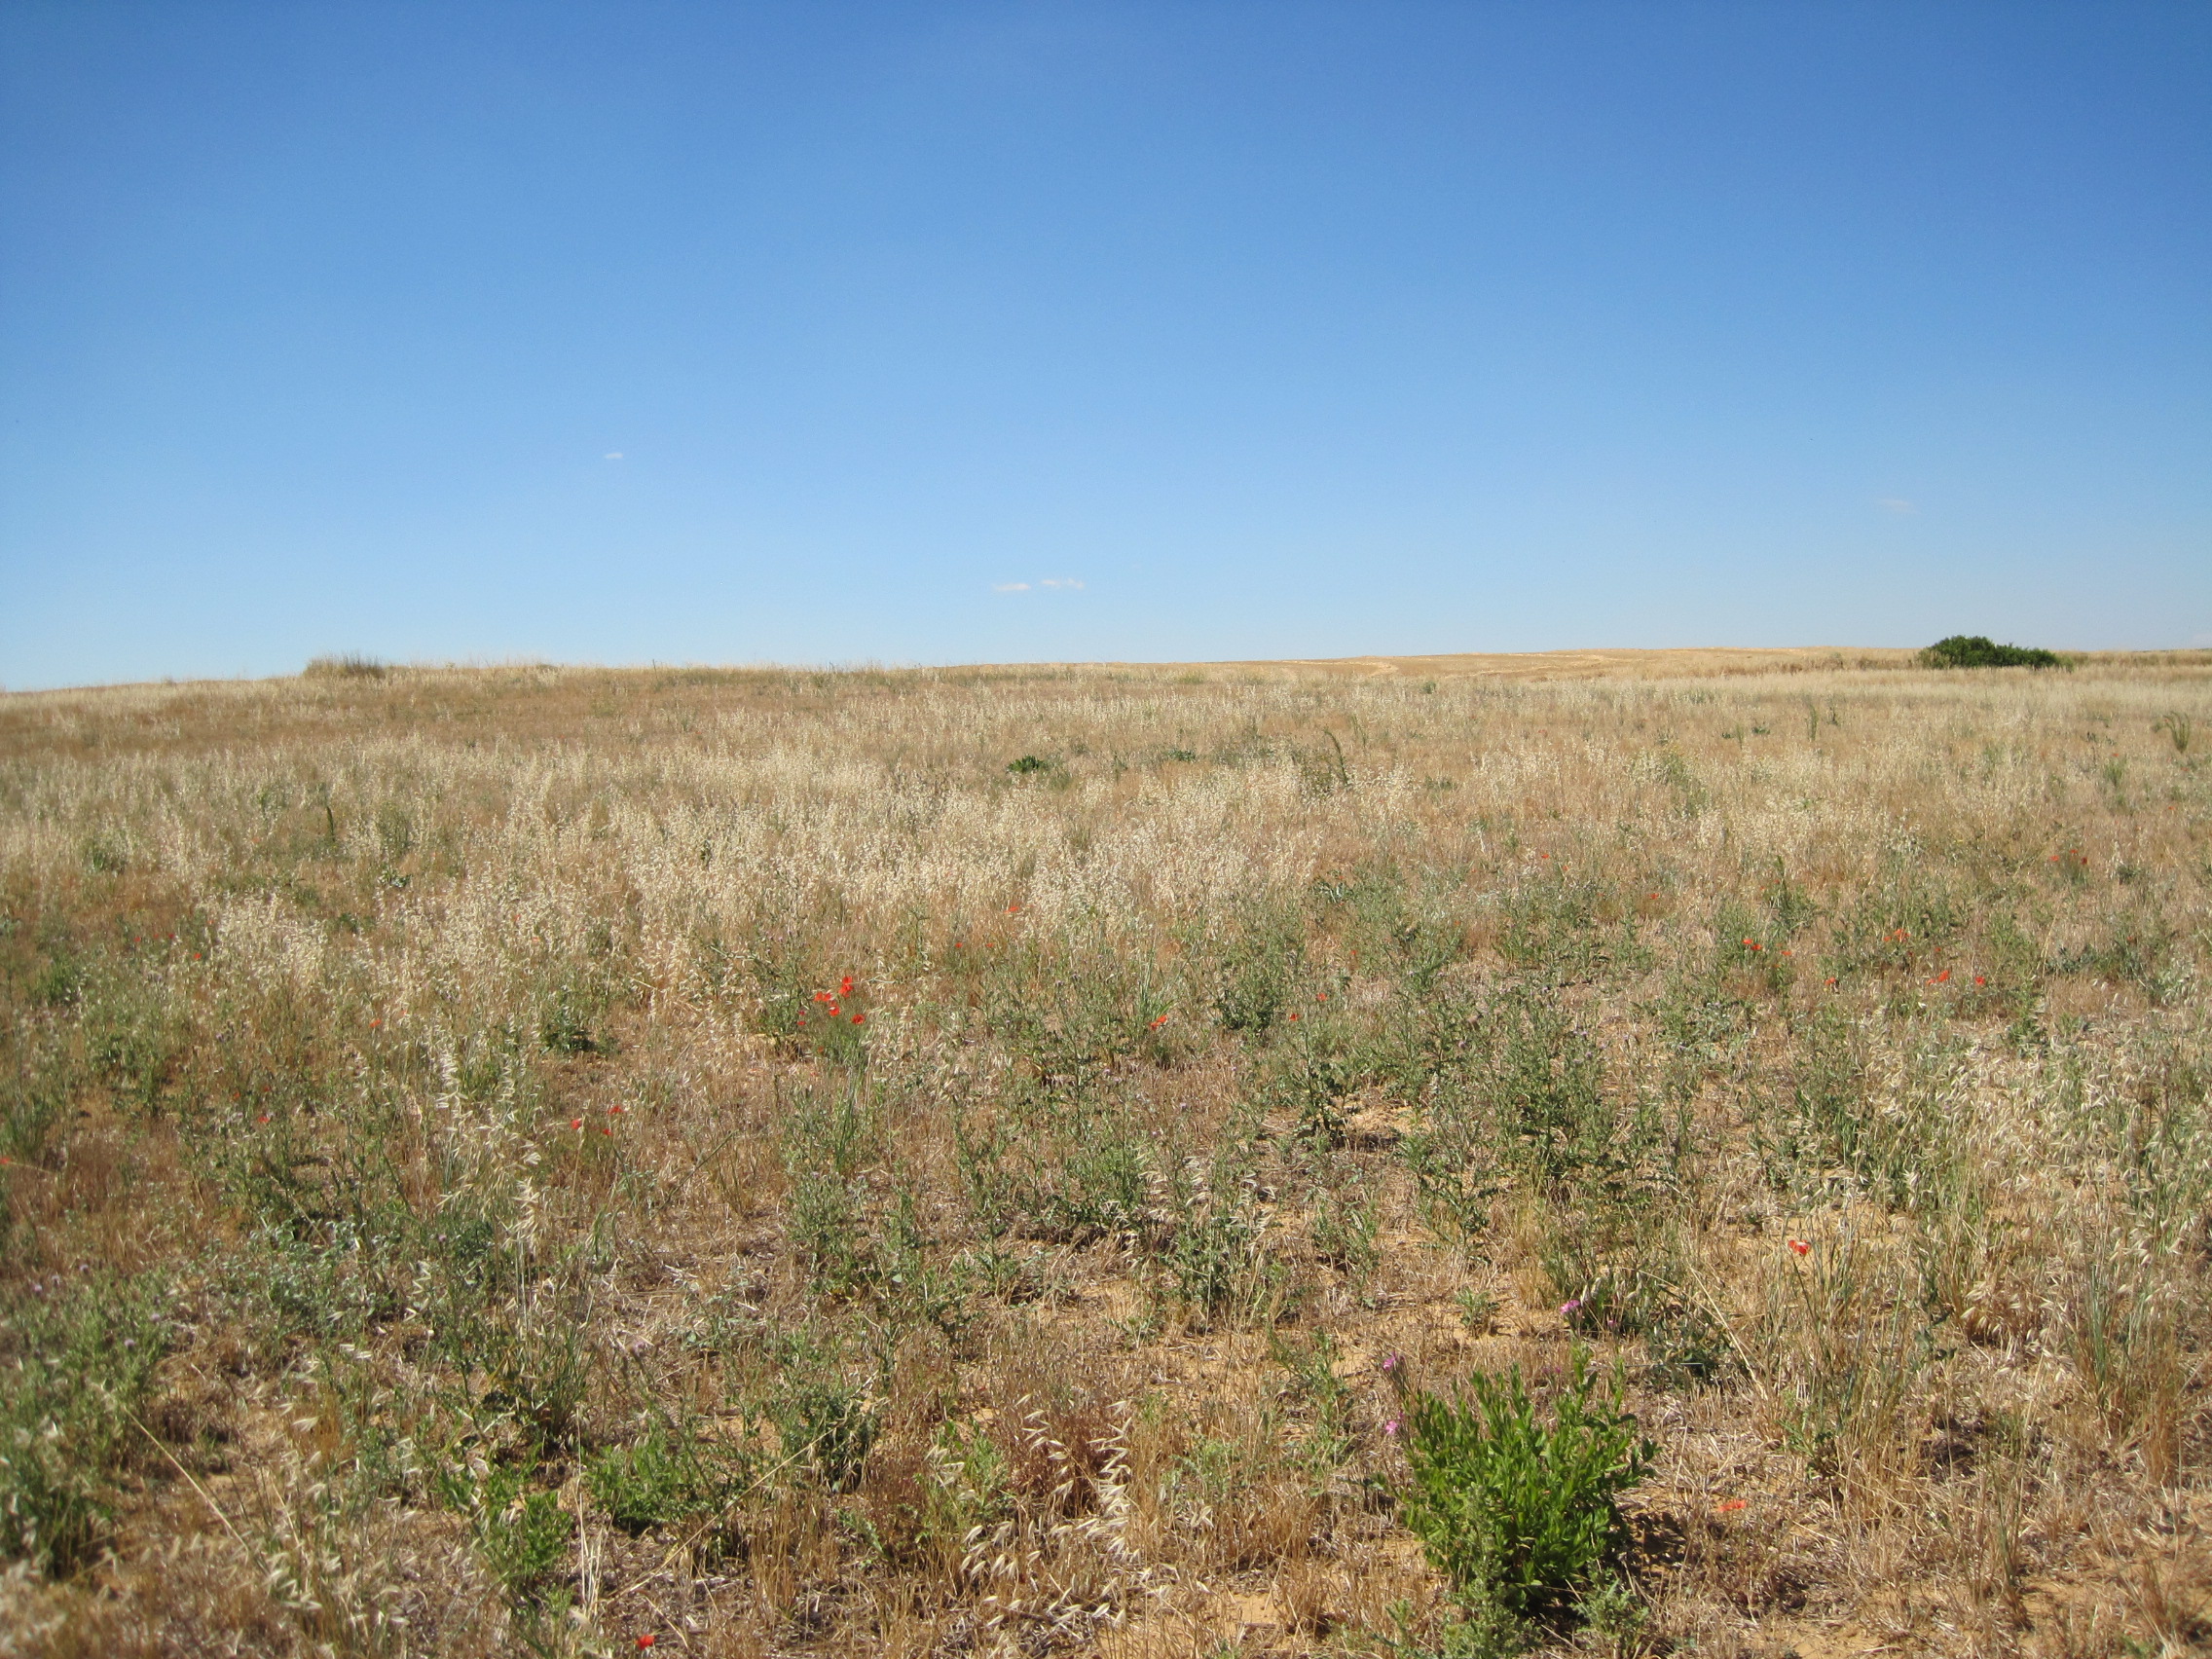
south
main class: Grassland
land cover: Spontaneously vegetated surfaces
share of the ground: > 75 %
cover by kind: herbaceous plants 90 %, unconsolidated bare surface 10 %
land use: Agriculture (excluding fallow land and kitchen gardens)
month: July
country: ES
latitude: 41.9772
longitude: -5.5485
